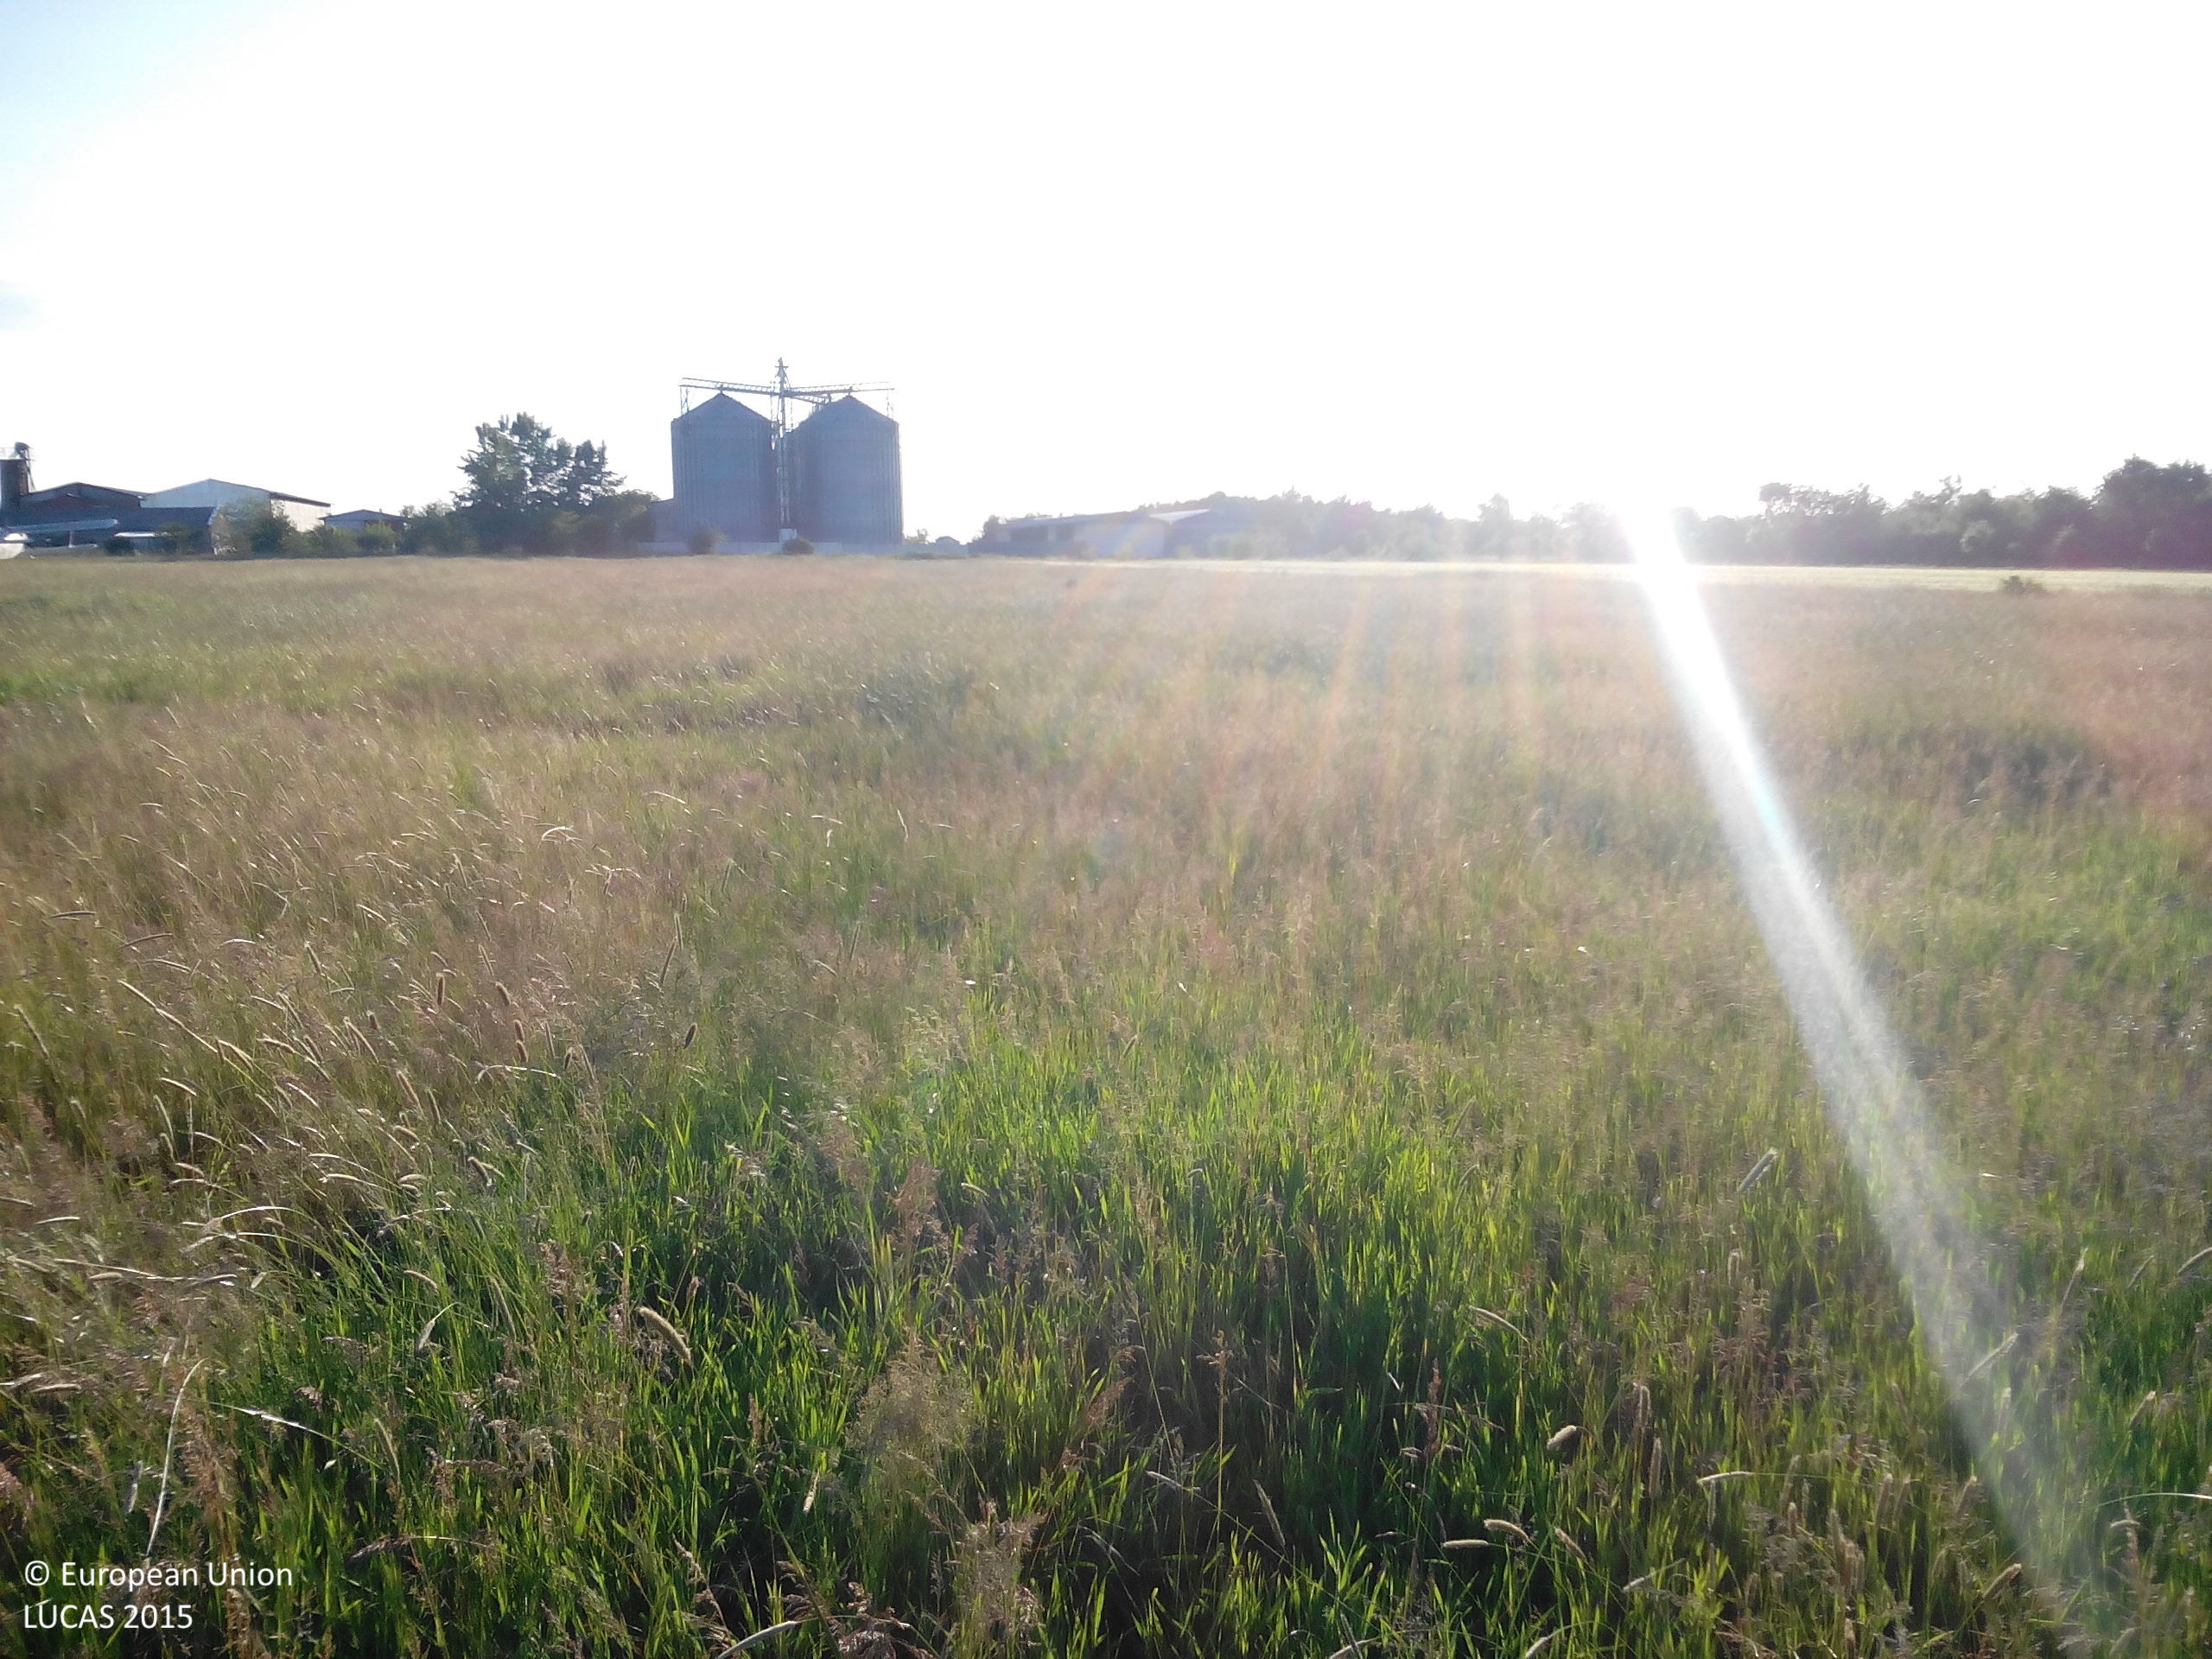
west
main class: Grassland
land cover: Grassland without tree/shrub cover
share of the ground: > 75 %
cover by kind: herbaceous plants 100 %
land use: Agriculture (excluding fallow land and kitchen gardens)
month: May
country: BG
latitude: 43.4272
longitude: 23.7721
